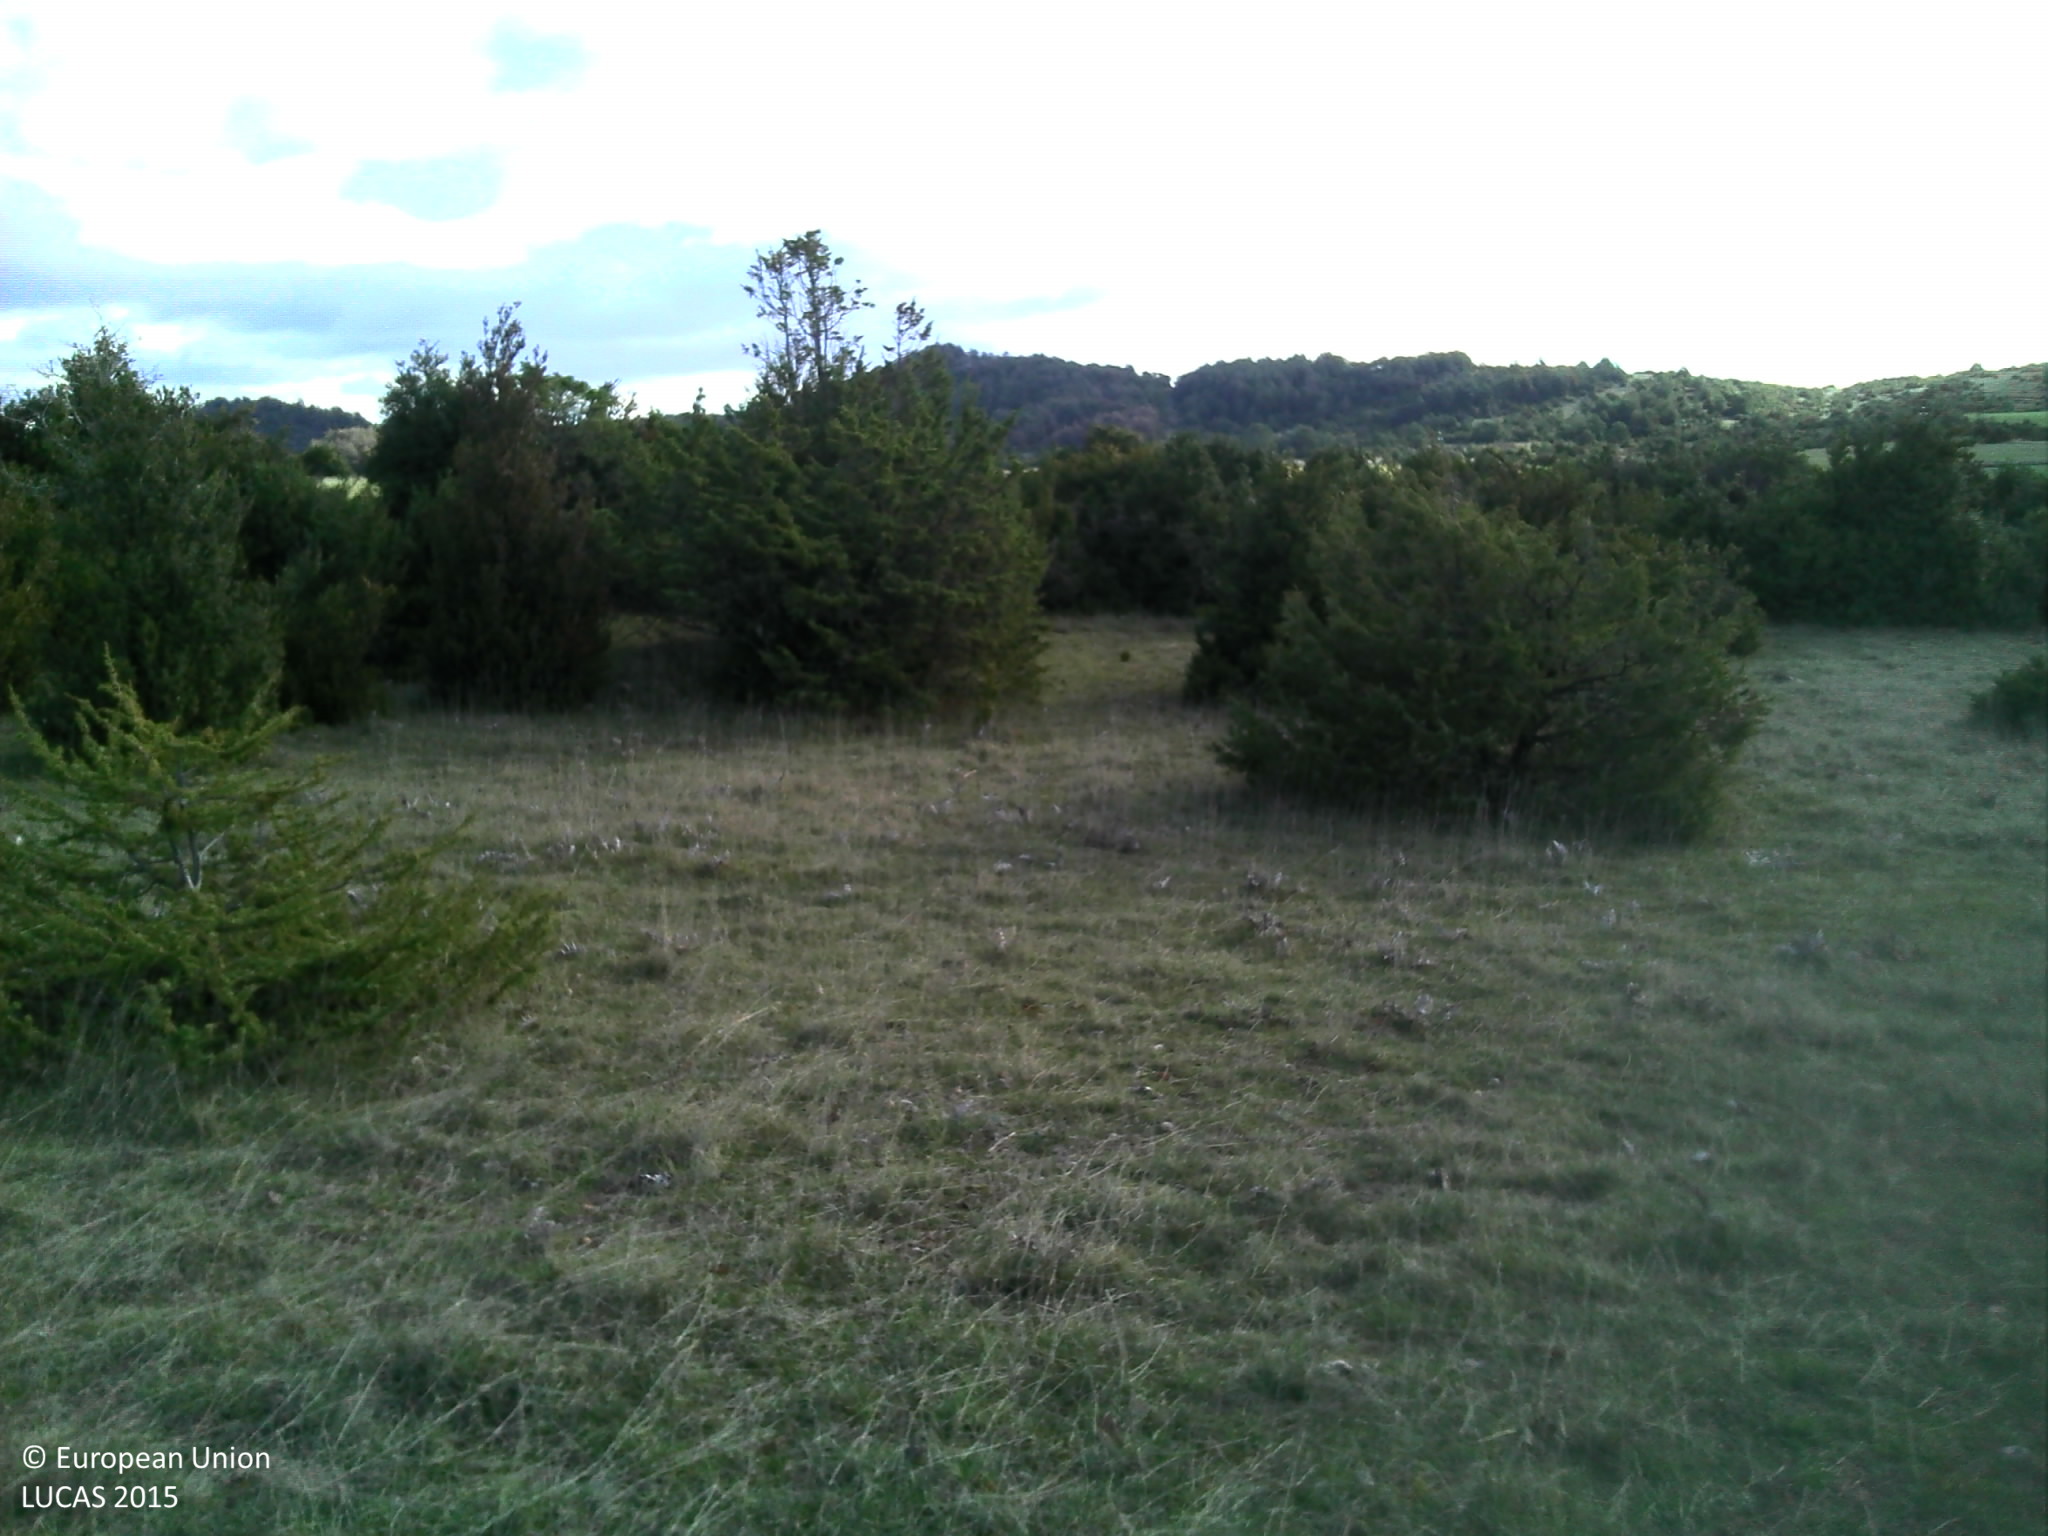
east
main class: Grassland
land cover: Grassland with sparse tree/shrub cover
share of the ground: > 75 %
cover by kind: herbaceous plants 90 %, coniferous forest trees 5 %, shrubs 5 %
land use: Agriculture (excluding fallow land and kitchen gardens)
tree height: < 5 m
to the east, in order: Grassland with sparse tree/shrub cover; Abandoned hedges; Grassland without tree/shrub cover; Dry stone walls; Abandoned hedges; Fences; Grassland with sparse tree/shrub cover; Grassland without tree/shrub cover
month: November
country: FR
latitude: 43.9148
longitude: 3.2700
